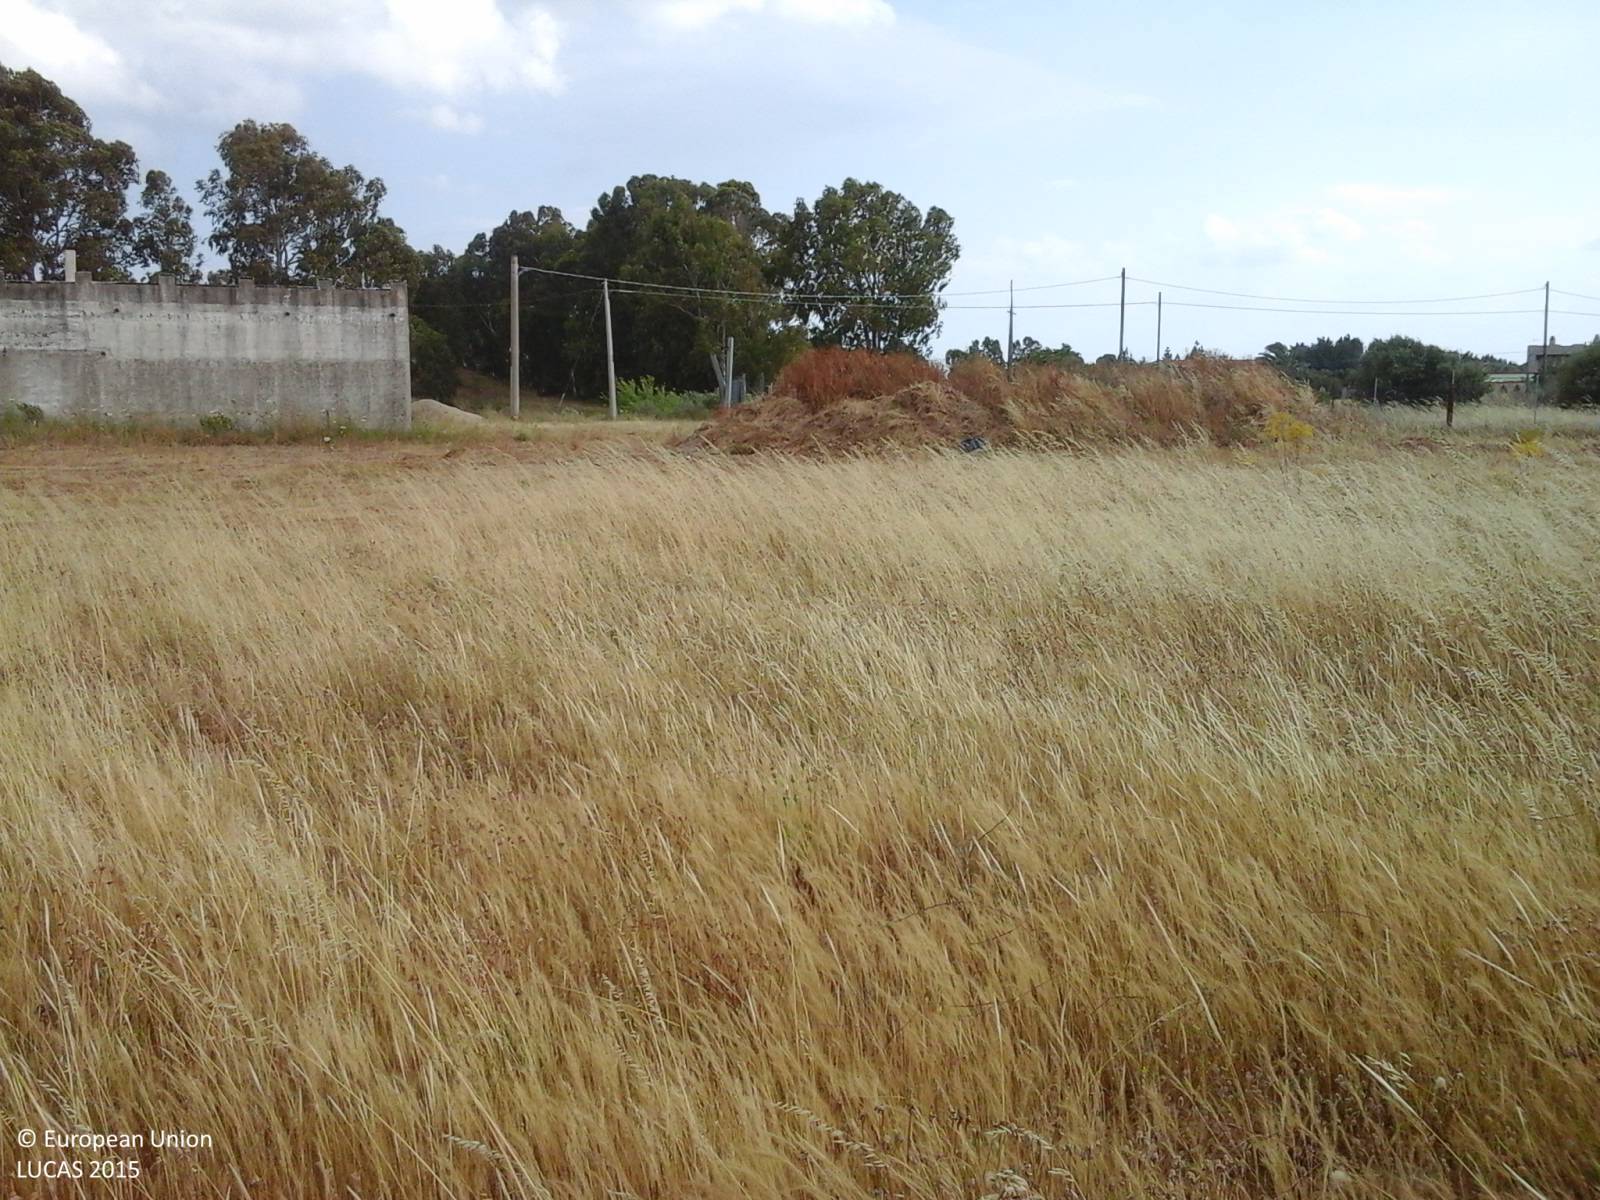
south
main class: Grassland
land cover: Spontaneously vegetated surfaces
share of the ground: > 75 %
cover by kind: herbaceous plants 100 %
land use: Fallow land
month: May
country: IT
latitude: 39.2503
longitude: 9.2745
